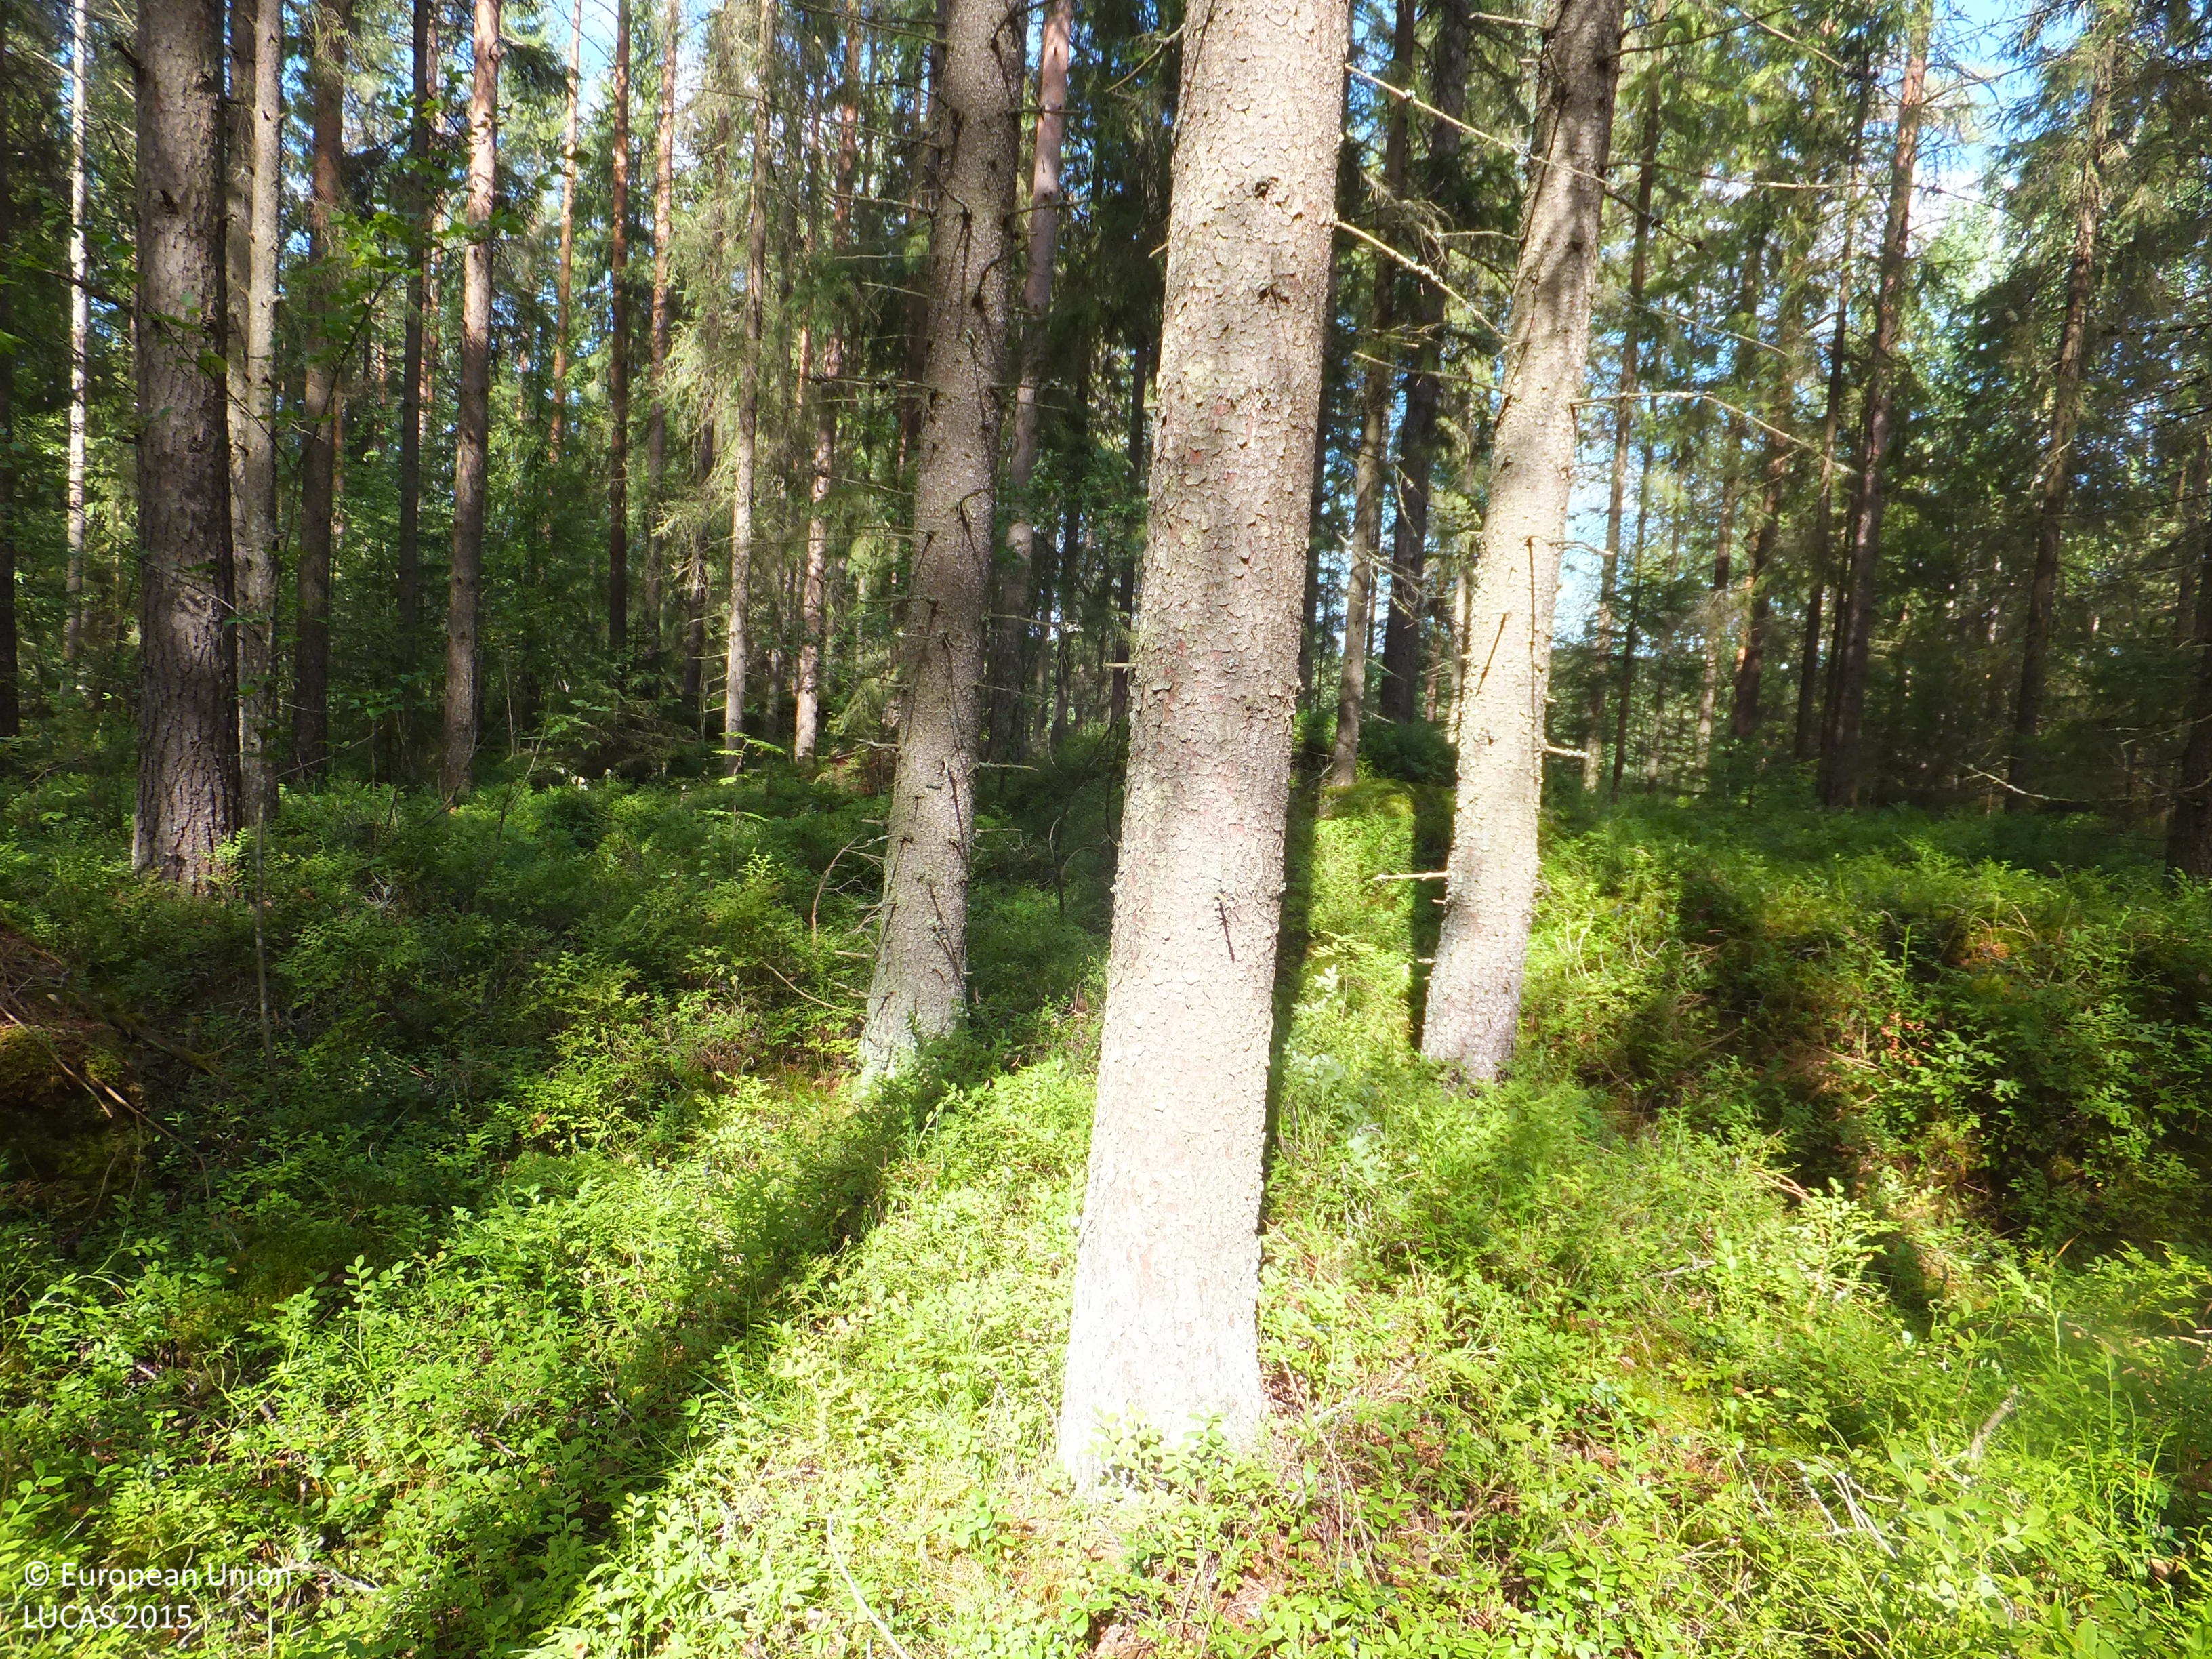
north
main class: Woodland
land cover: Other coniferous woodland
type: boreal forest
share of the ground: > 75 %
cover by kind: coniferous forest trees 75 %, shrubs 10 %, lichens and mosses 10 %, broadleaved forest trees 5 %
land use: Forestry
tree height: > 5 m
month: August
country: FI
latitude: 63.2292
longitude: 23.0924
